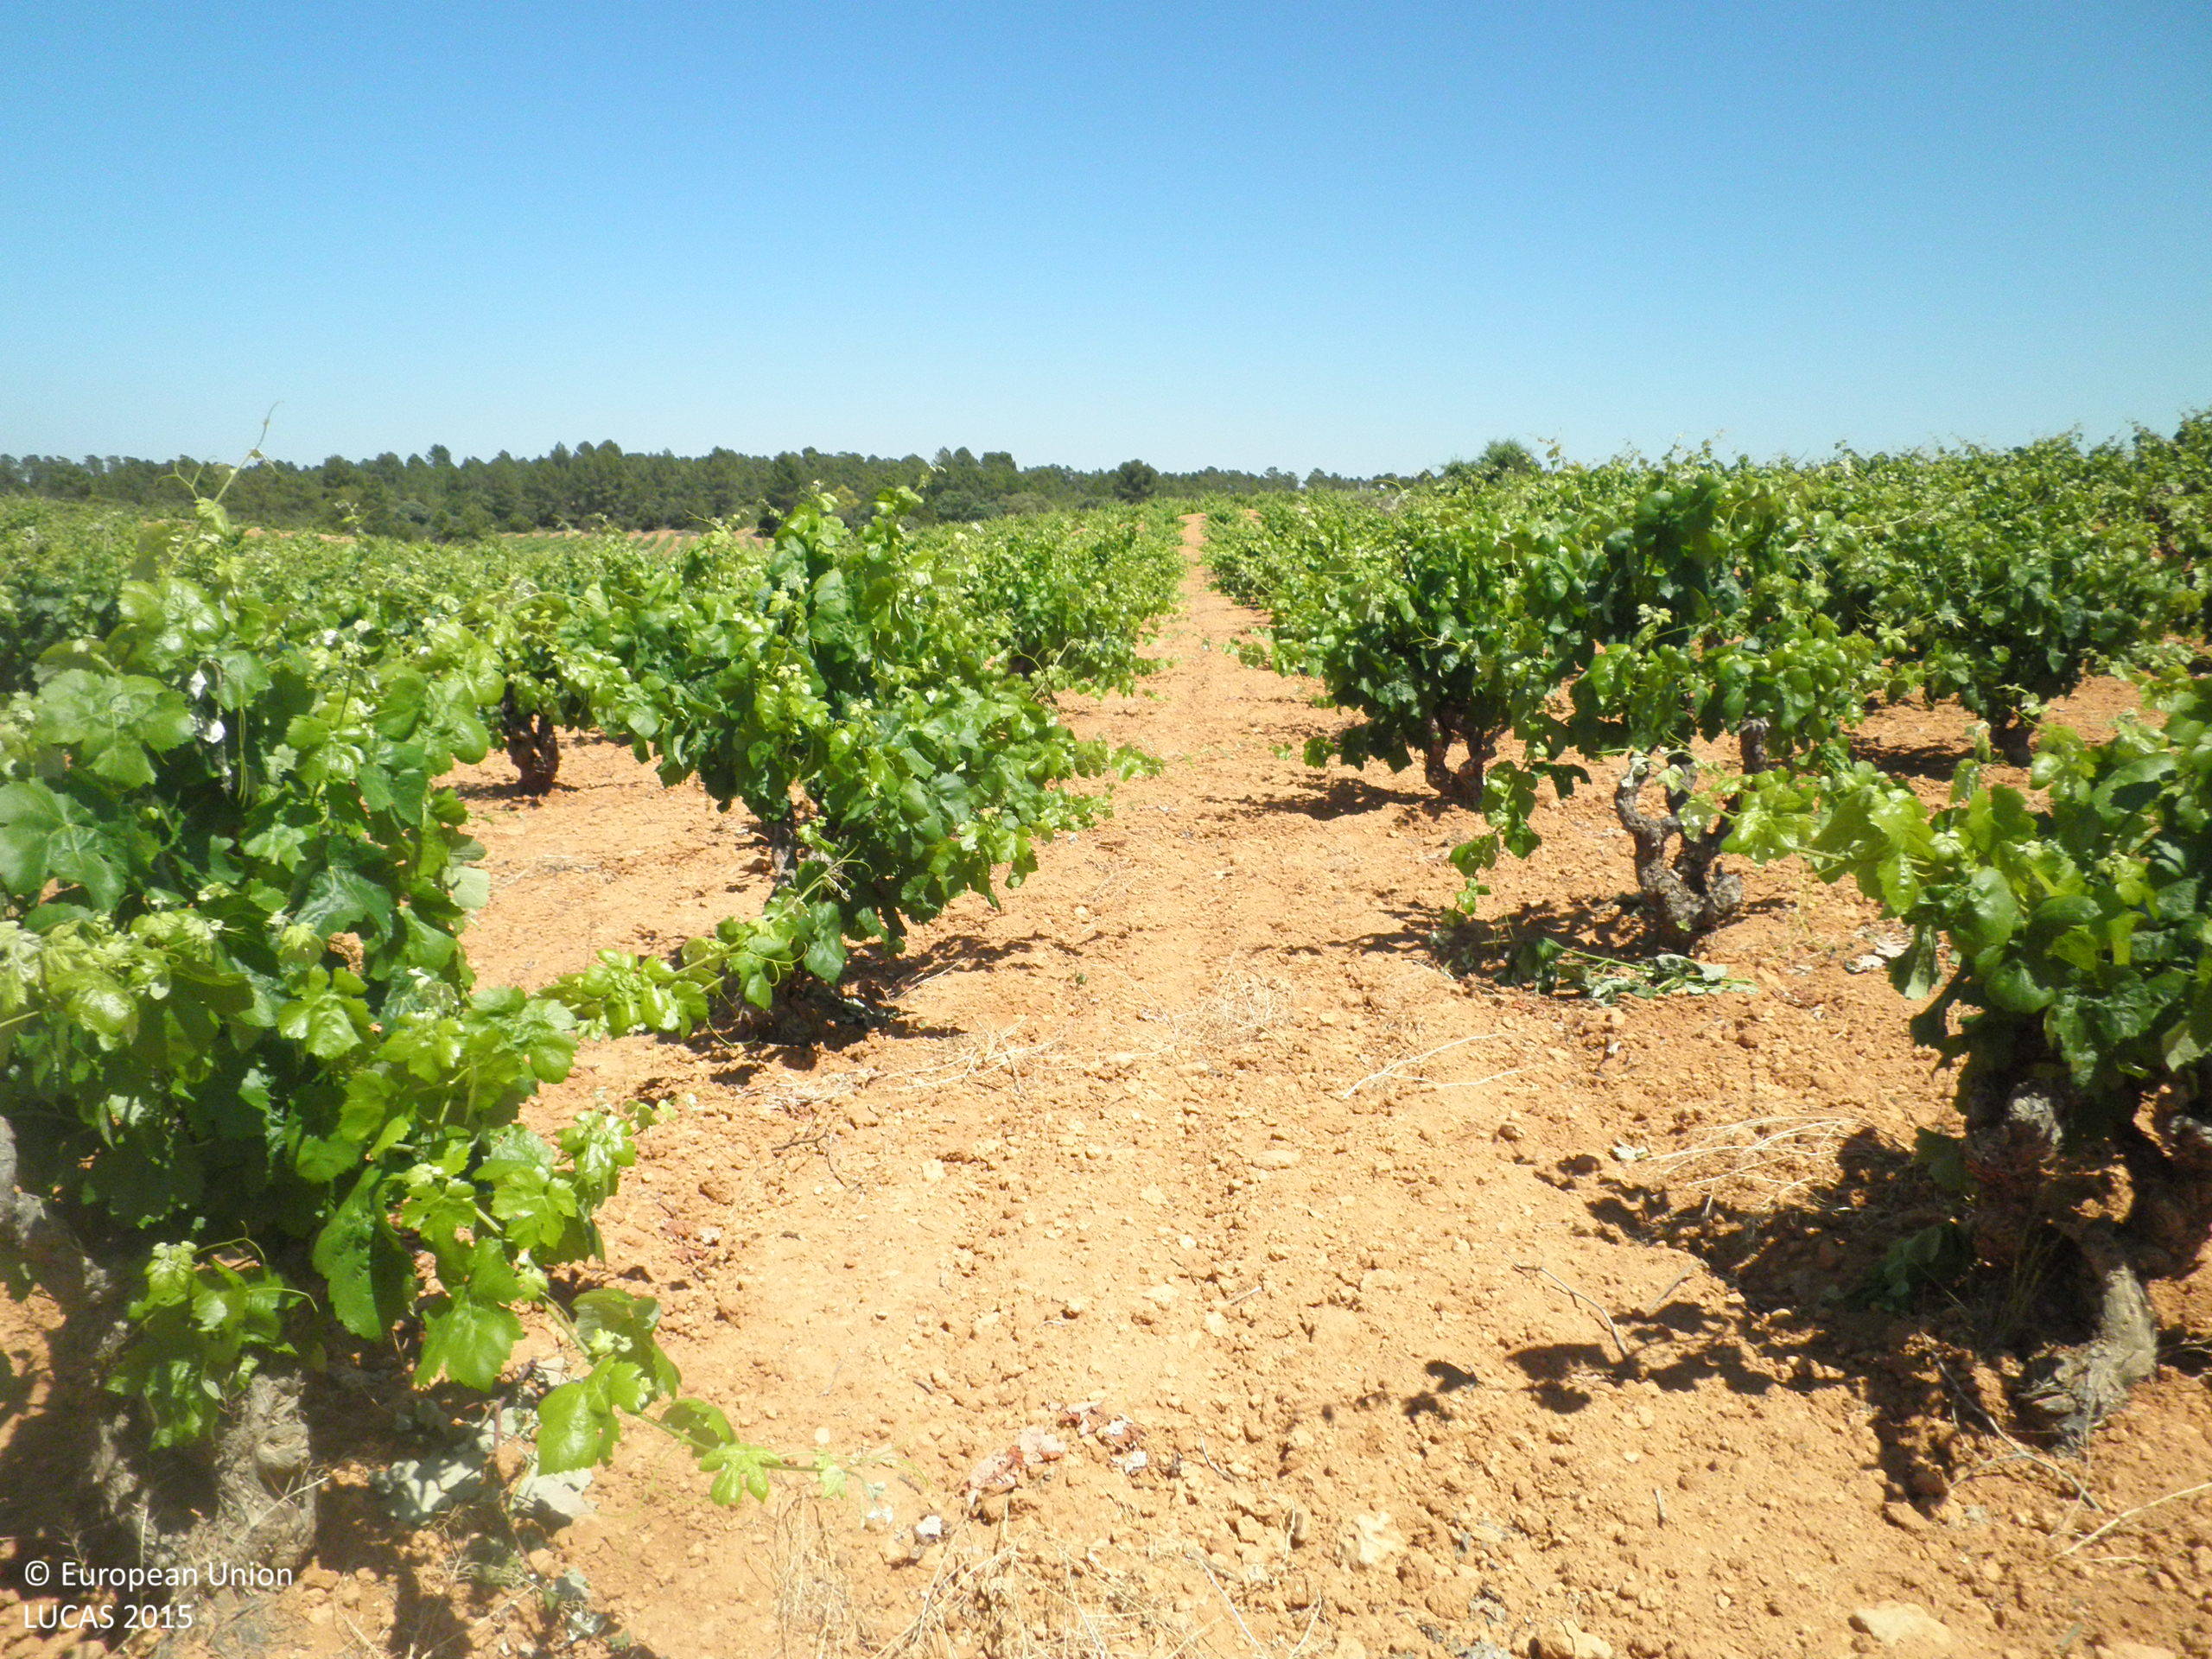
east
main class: Cropland
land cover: Vineyards
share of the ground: 10 - 25 %
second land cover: Other bare soil
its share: > 75 %
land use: Agriculture (excluding fallow land and kitchen gardens)
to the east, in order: Vineyards; Other bare soil; Grass margins; Vineyards; Tracks; Broadleaved woodland; Vineyards
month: June
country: ES
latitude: 39.5162
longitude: -1.6485
